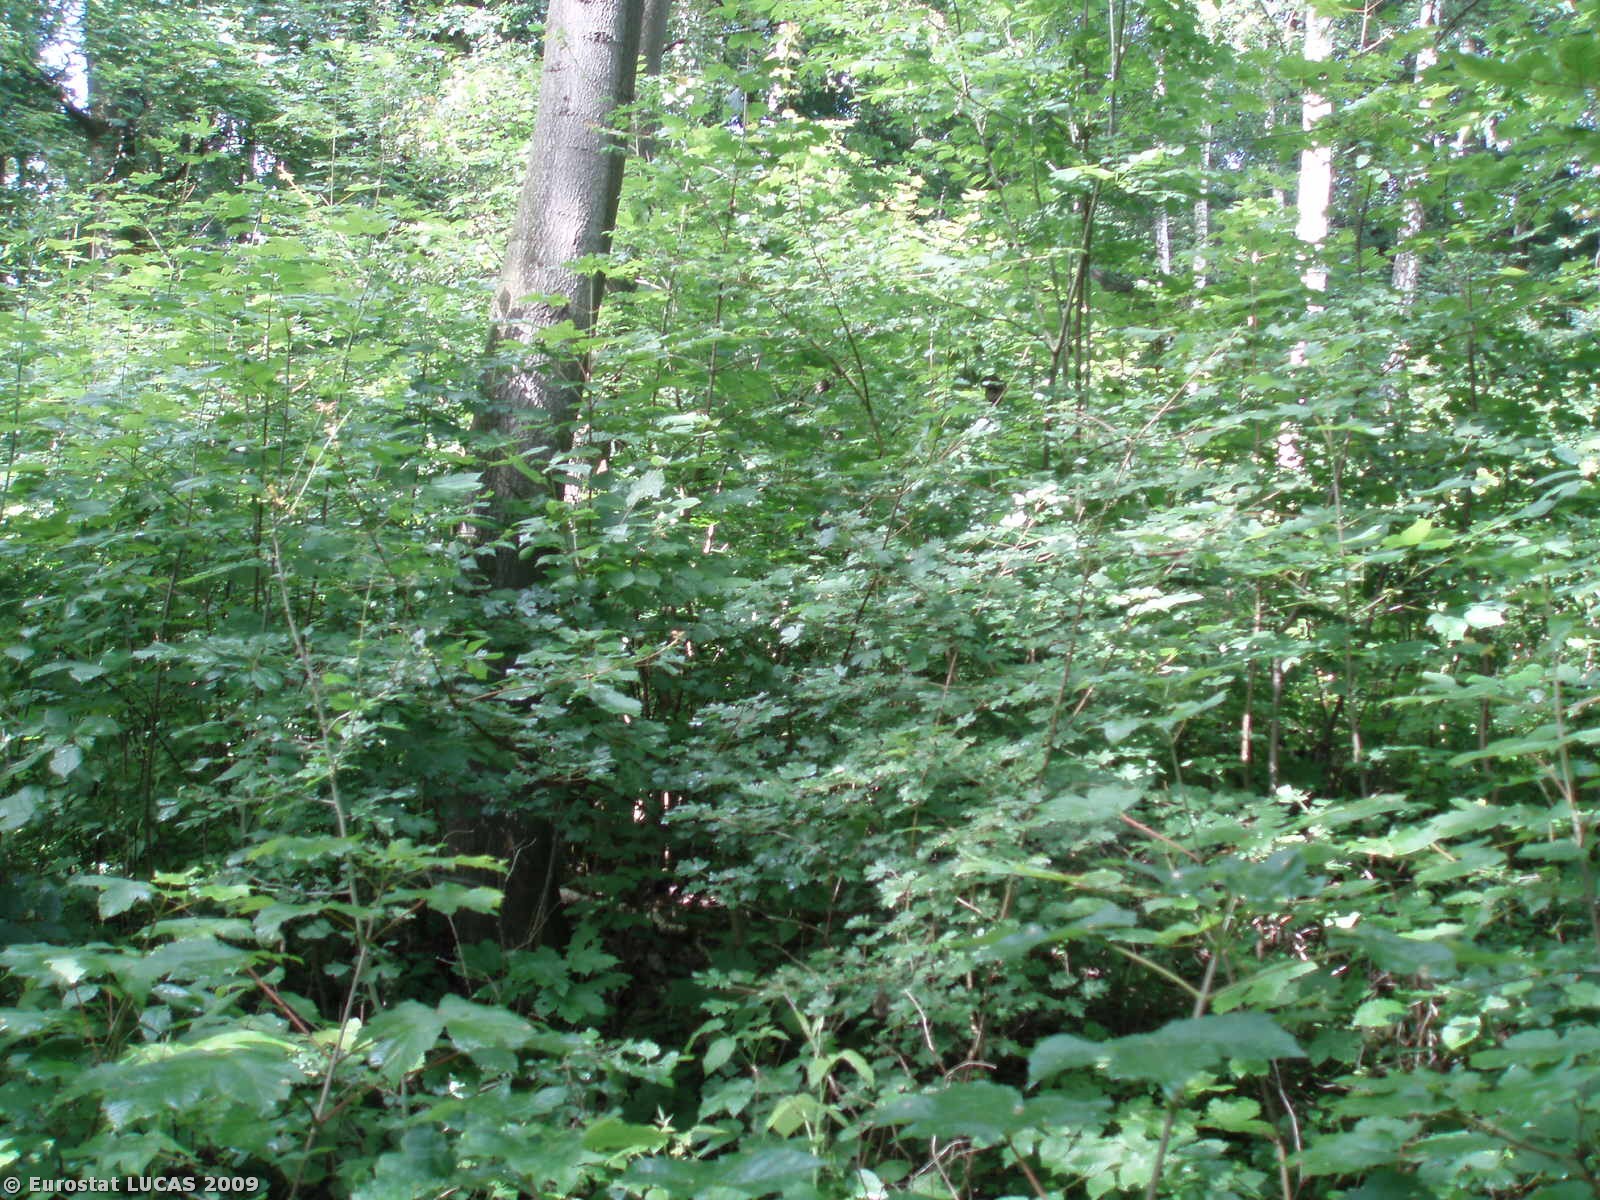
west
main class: Woodland
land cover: Broadleaved woodland
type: mesophytic deciduous forest
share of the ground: > 75 %
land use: Forestry
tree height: > 5 m
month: July
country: CZ
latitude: 50.6850
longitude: 14.1483
